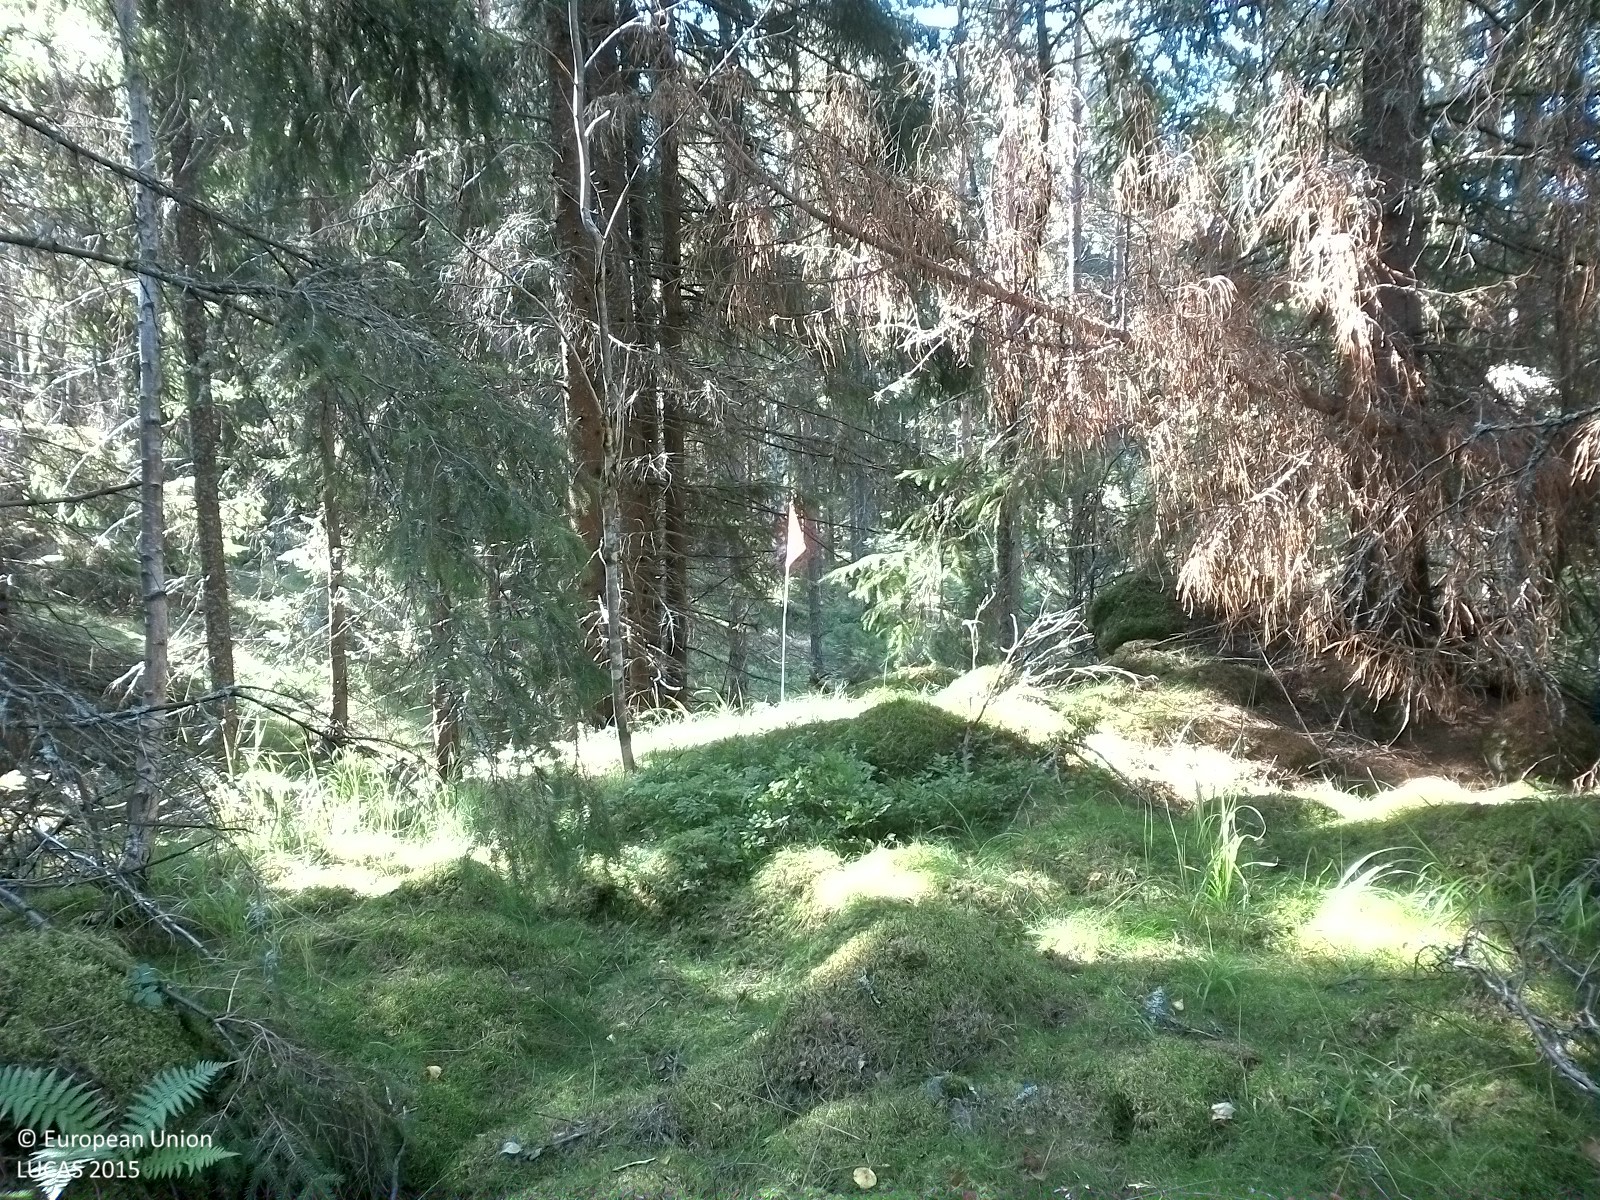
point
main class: Woodland
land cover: Spruce dominated mixed woodland
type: boreal forest
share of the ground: 50 - 75 %
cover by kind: coniferous forest trees 35 %, lichens and mosses 30 %, broadleaved forest trees 15 %, herbaceous plants 15 %, shrubs 5 %
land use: Forestry
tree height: > 5 m
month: August
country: SE
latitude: 58.7746
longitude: 15.0257
